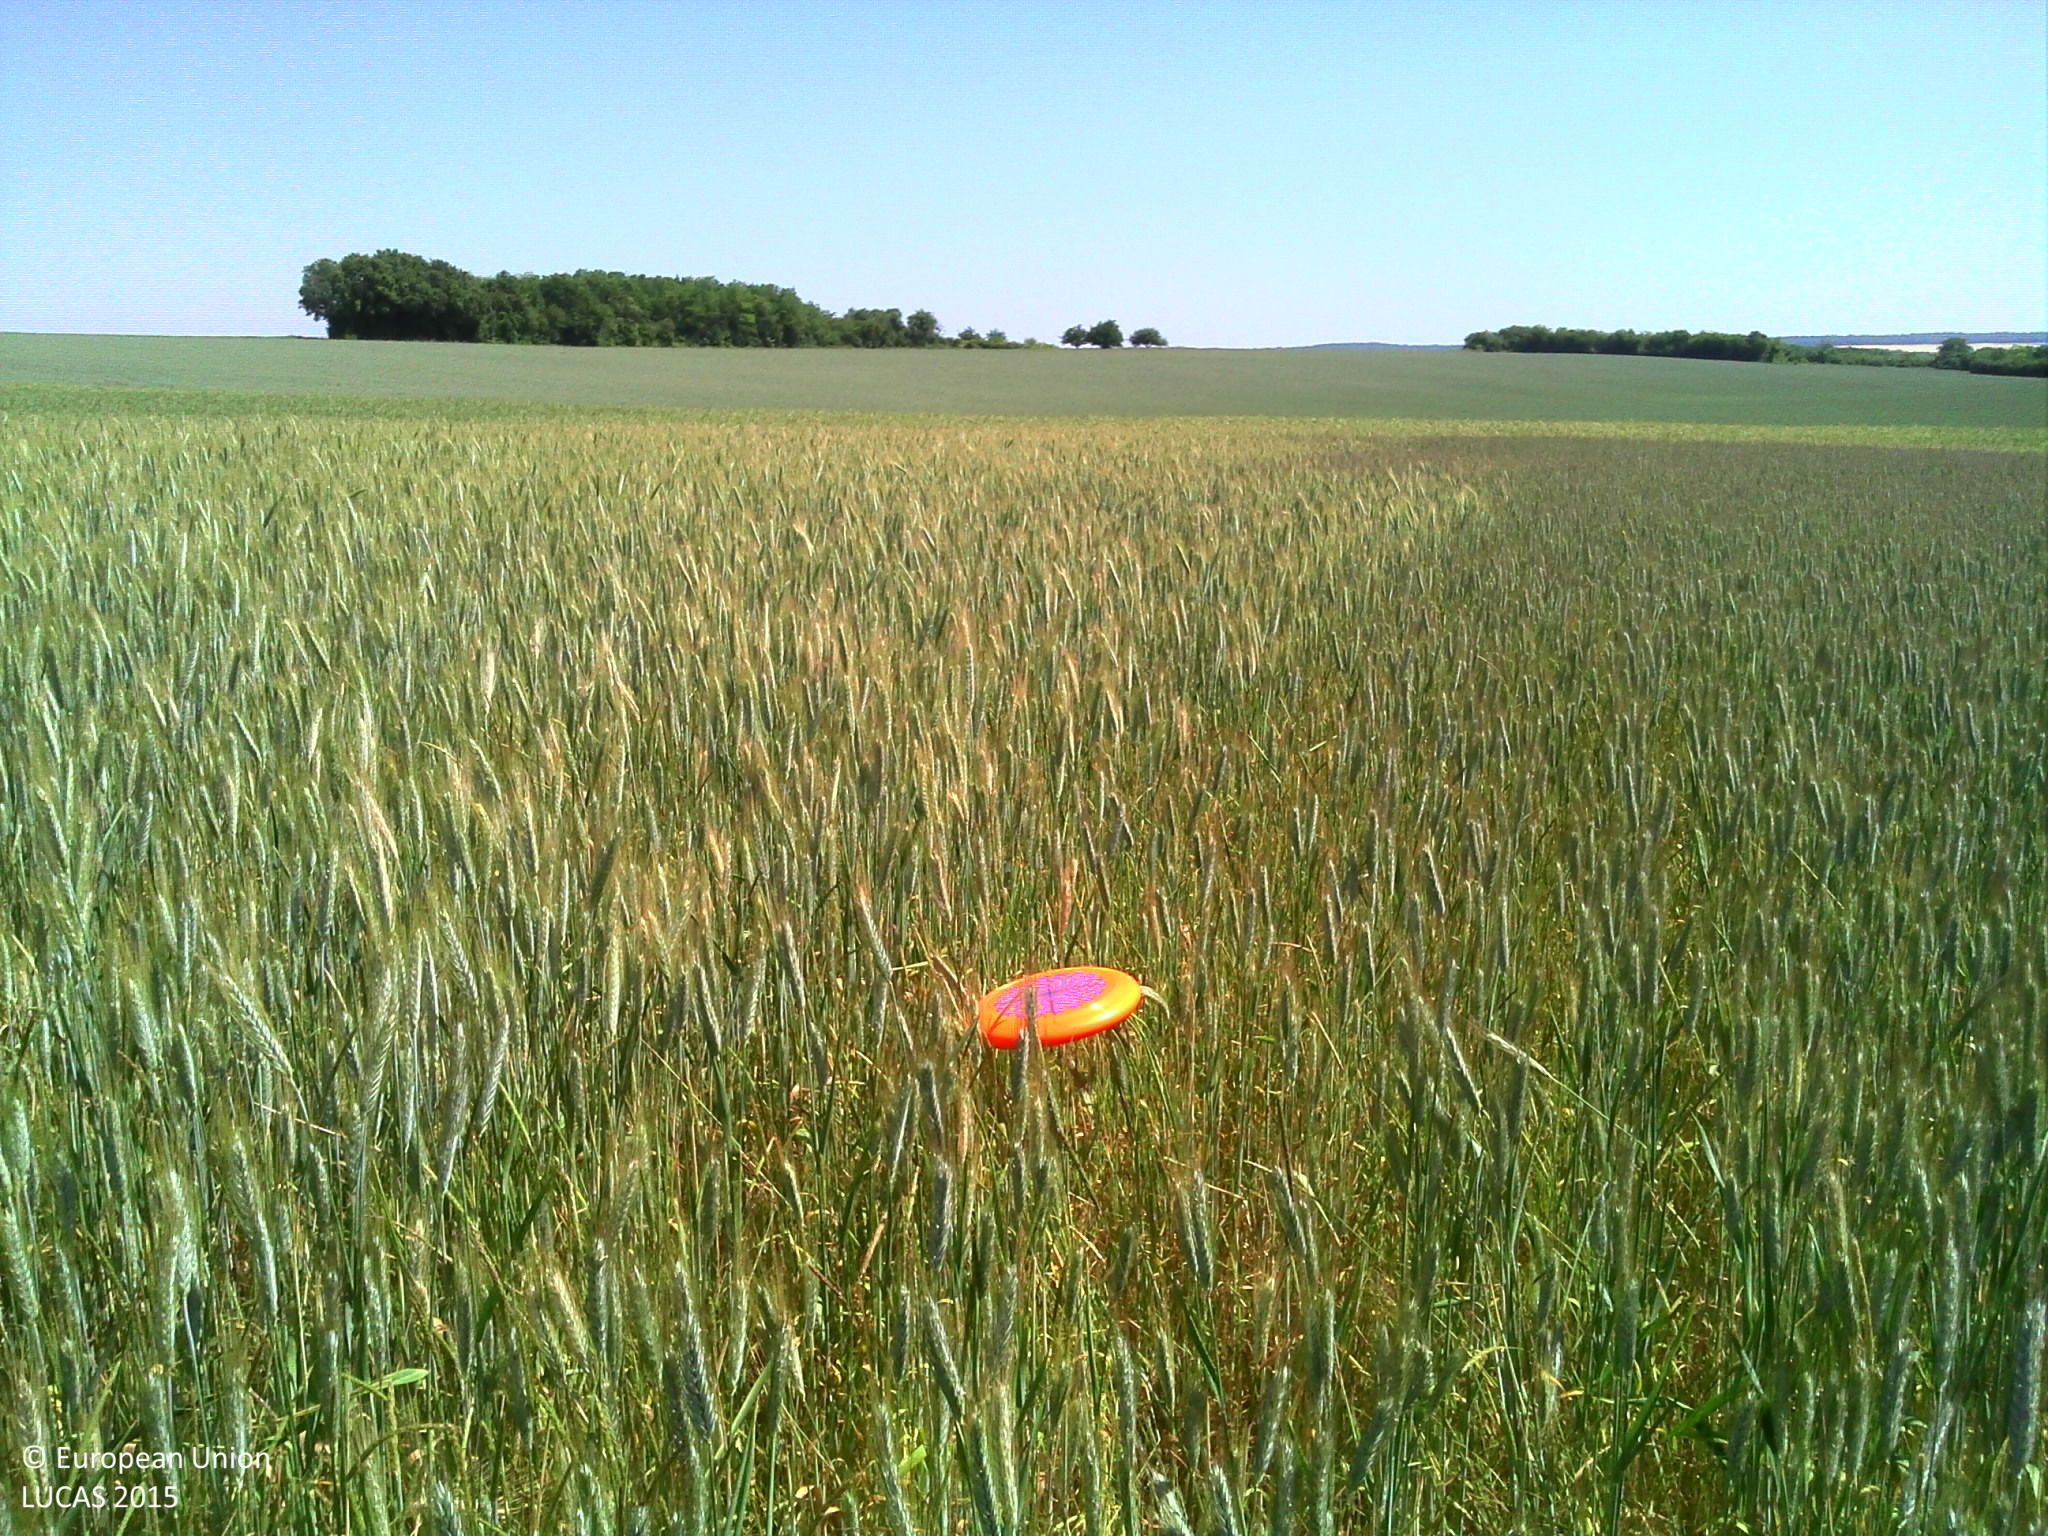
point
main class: Cropland
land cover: Triticale
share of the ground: > 75 %
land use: Agriculture (excluding fallow land and kitchen gardens)
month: June
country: FR
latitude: 47.5880
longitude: 3.9471
